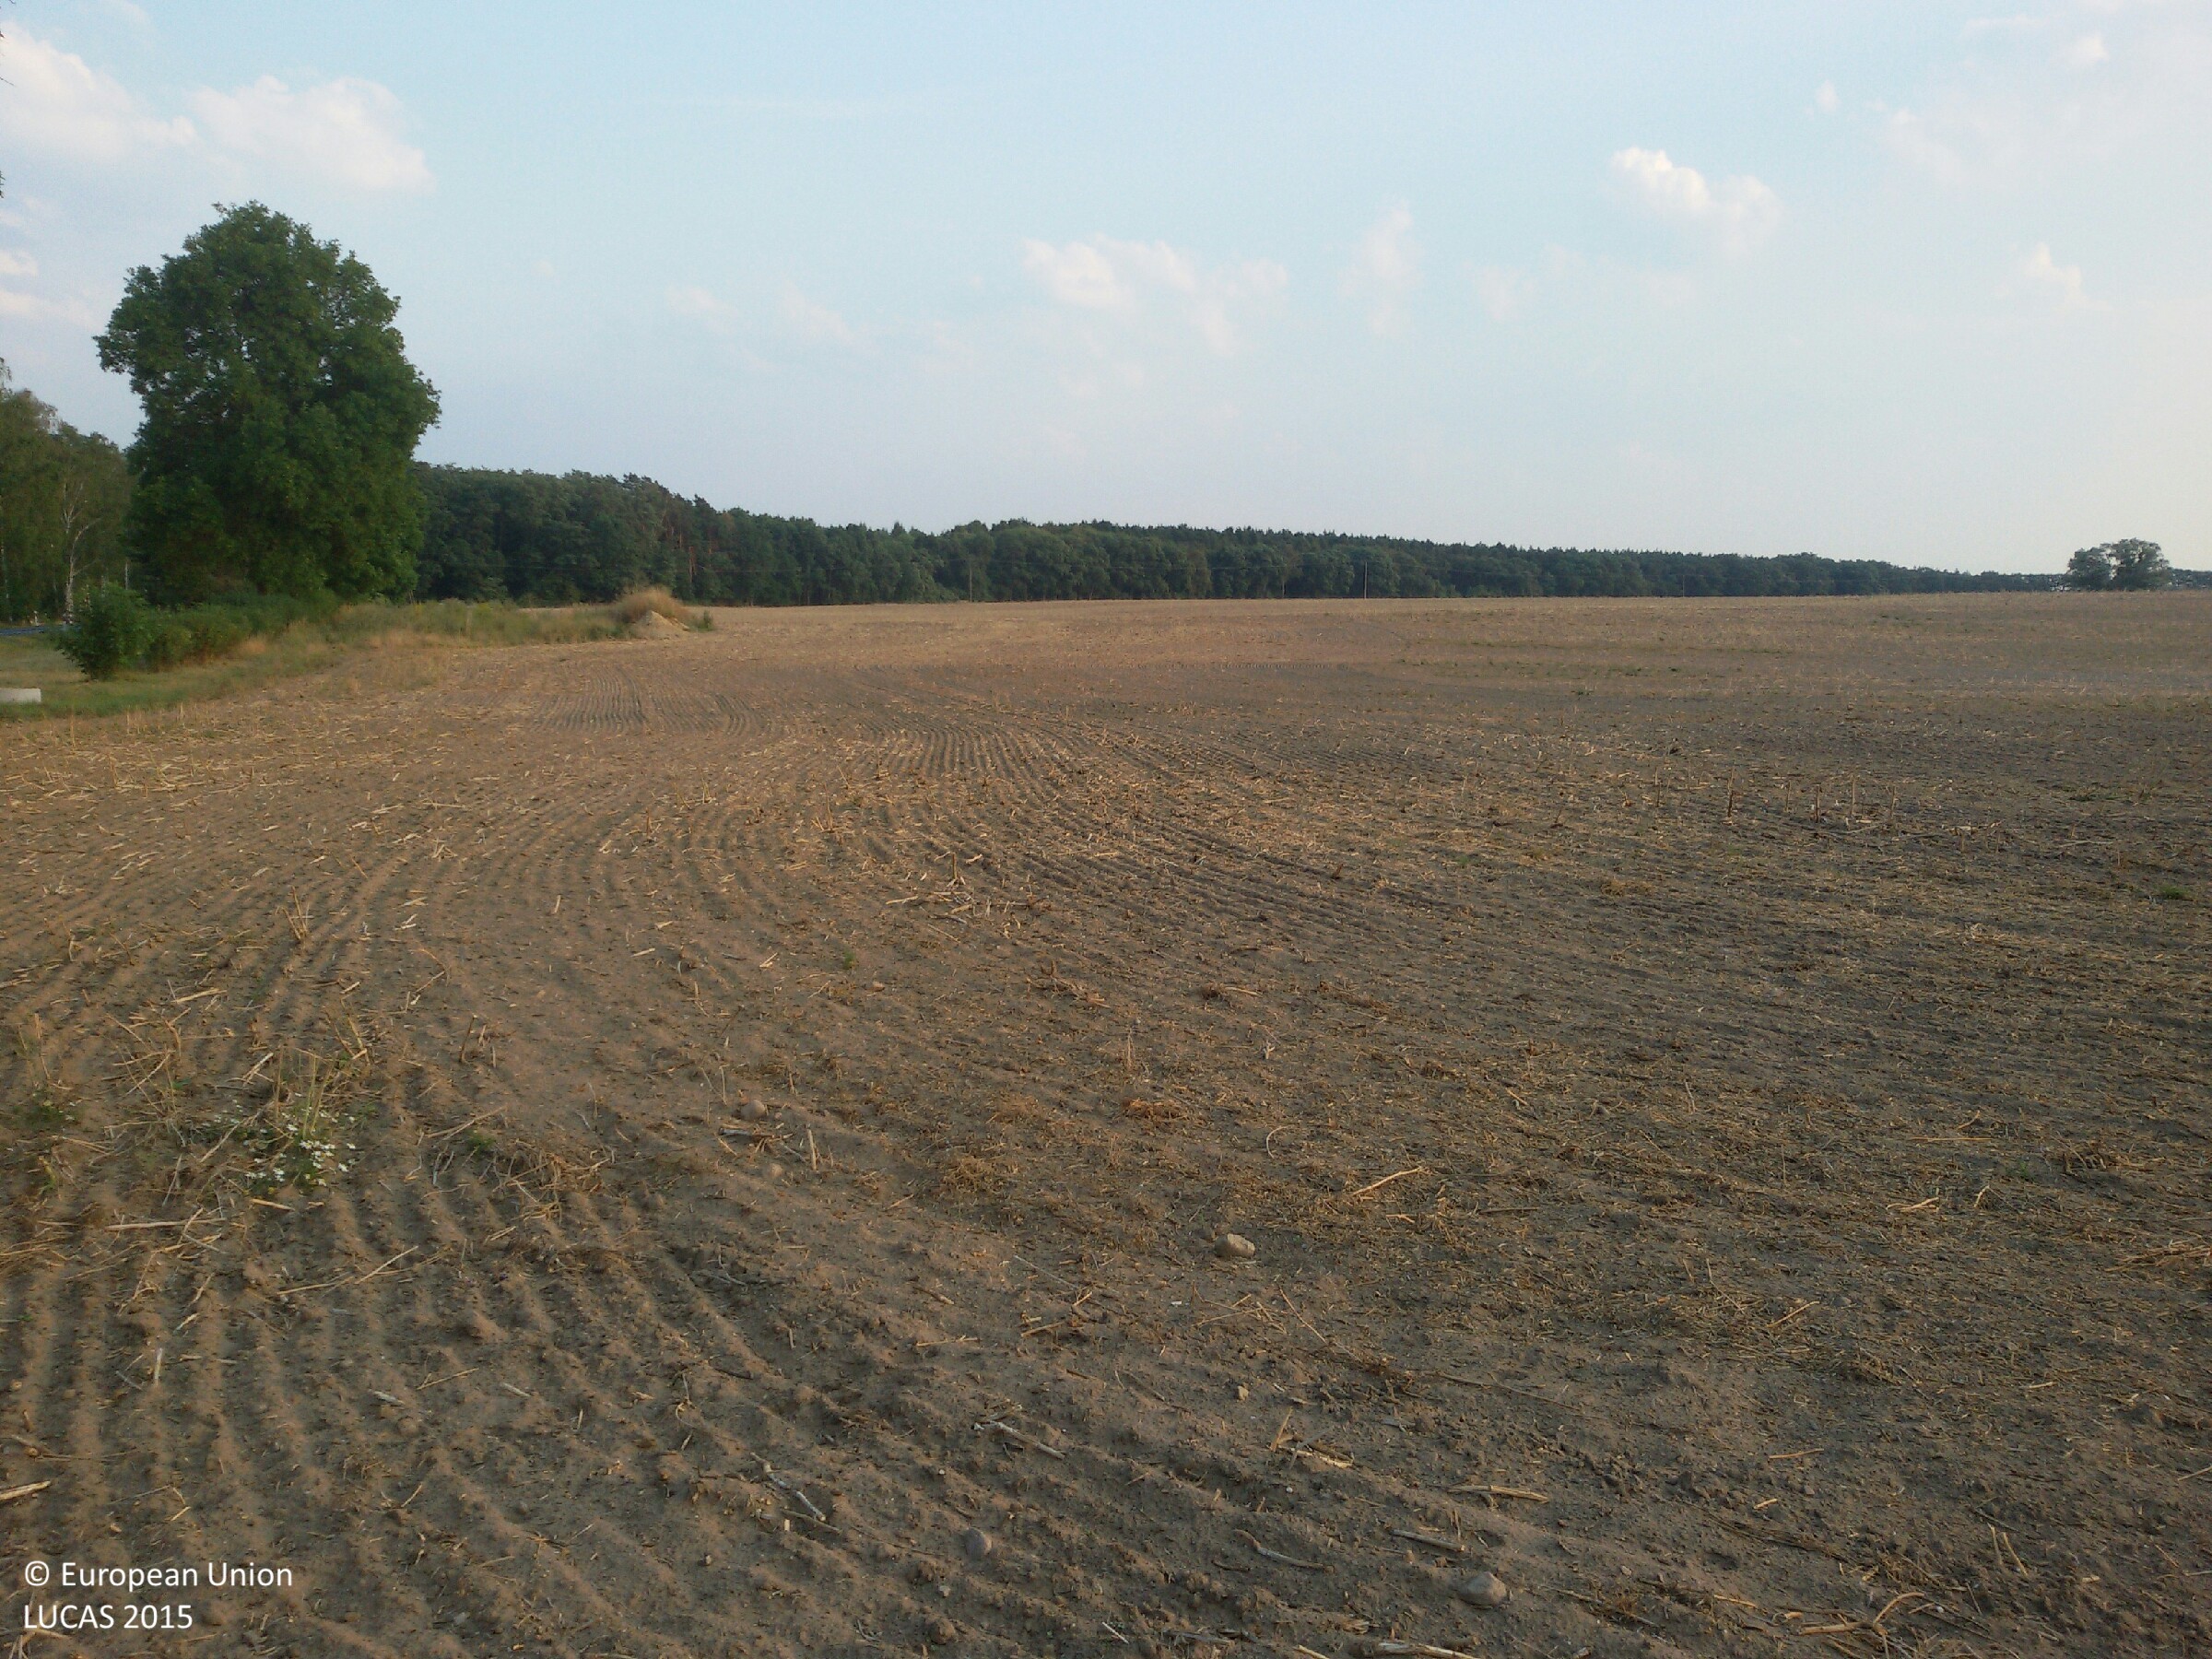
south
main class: Cropland
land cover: Rape and turnip rape
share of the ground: < 10 %
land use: Agriculture (excluding fallow land and kitchen gardens)
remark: Harvested field
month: August
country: PL
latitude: 52.9242
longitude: 14.4488
